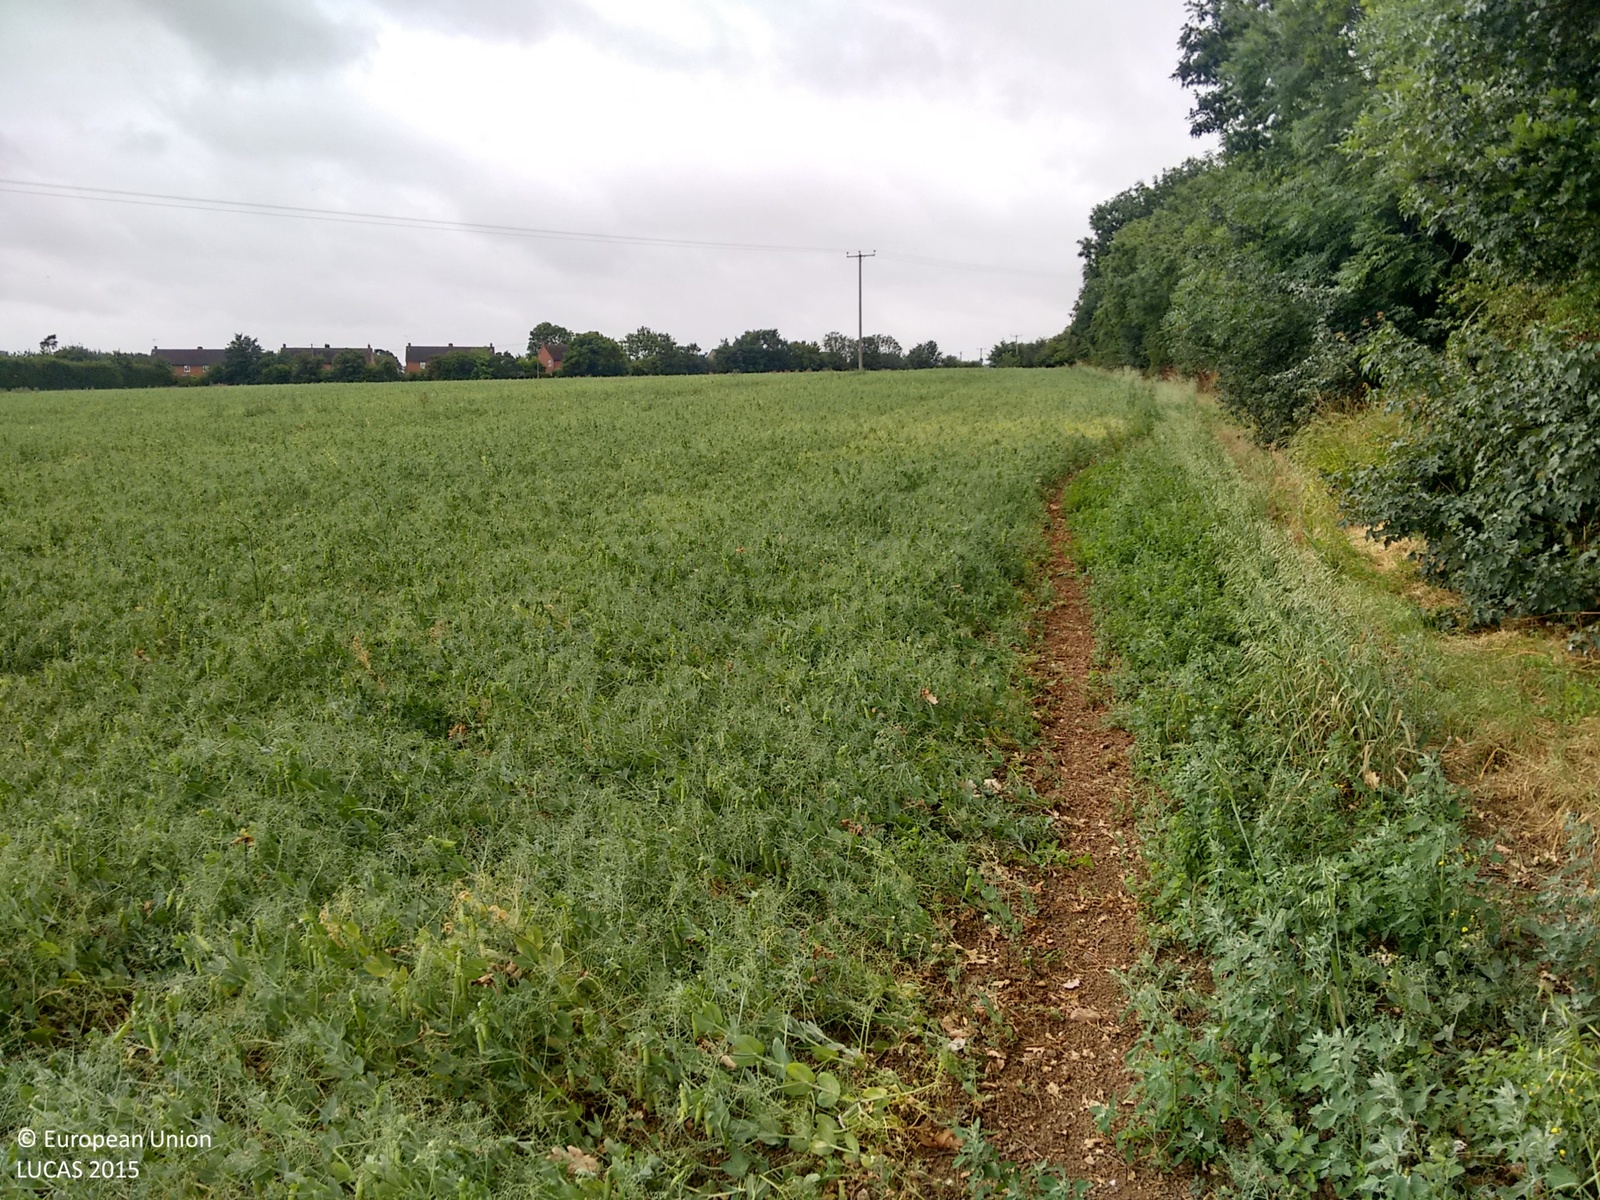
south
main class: Cropland
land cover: Dry pulses
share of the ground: > 75 %
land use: Agriculture (excluding fallow land and kitchen gardens)
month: July
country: GB
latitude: 51.7779
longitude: 0.2735
